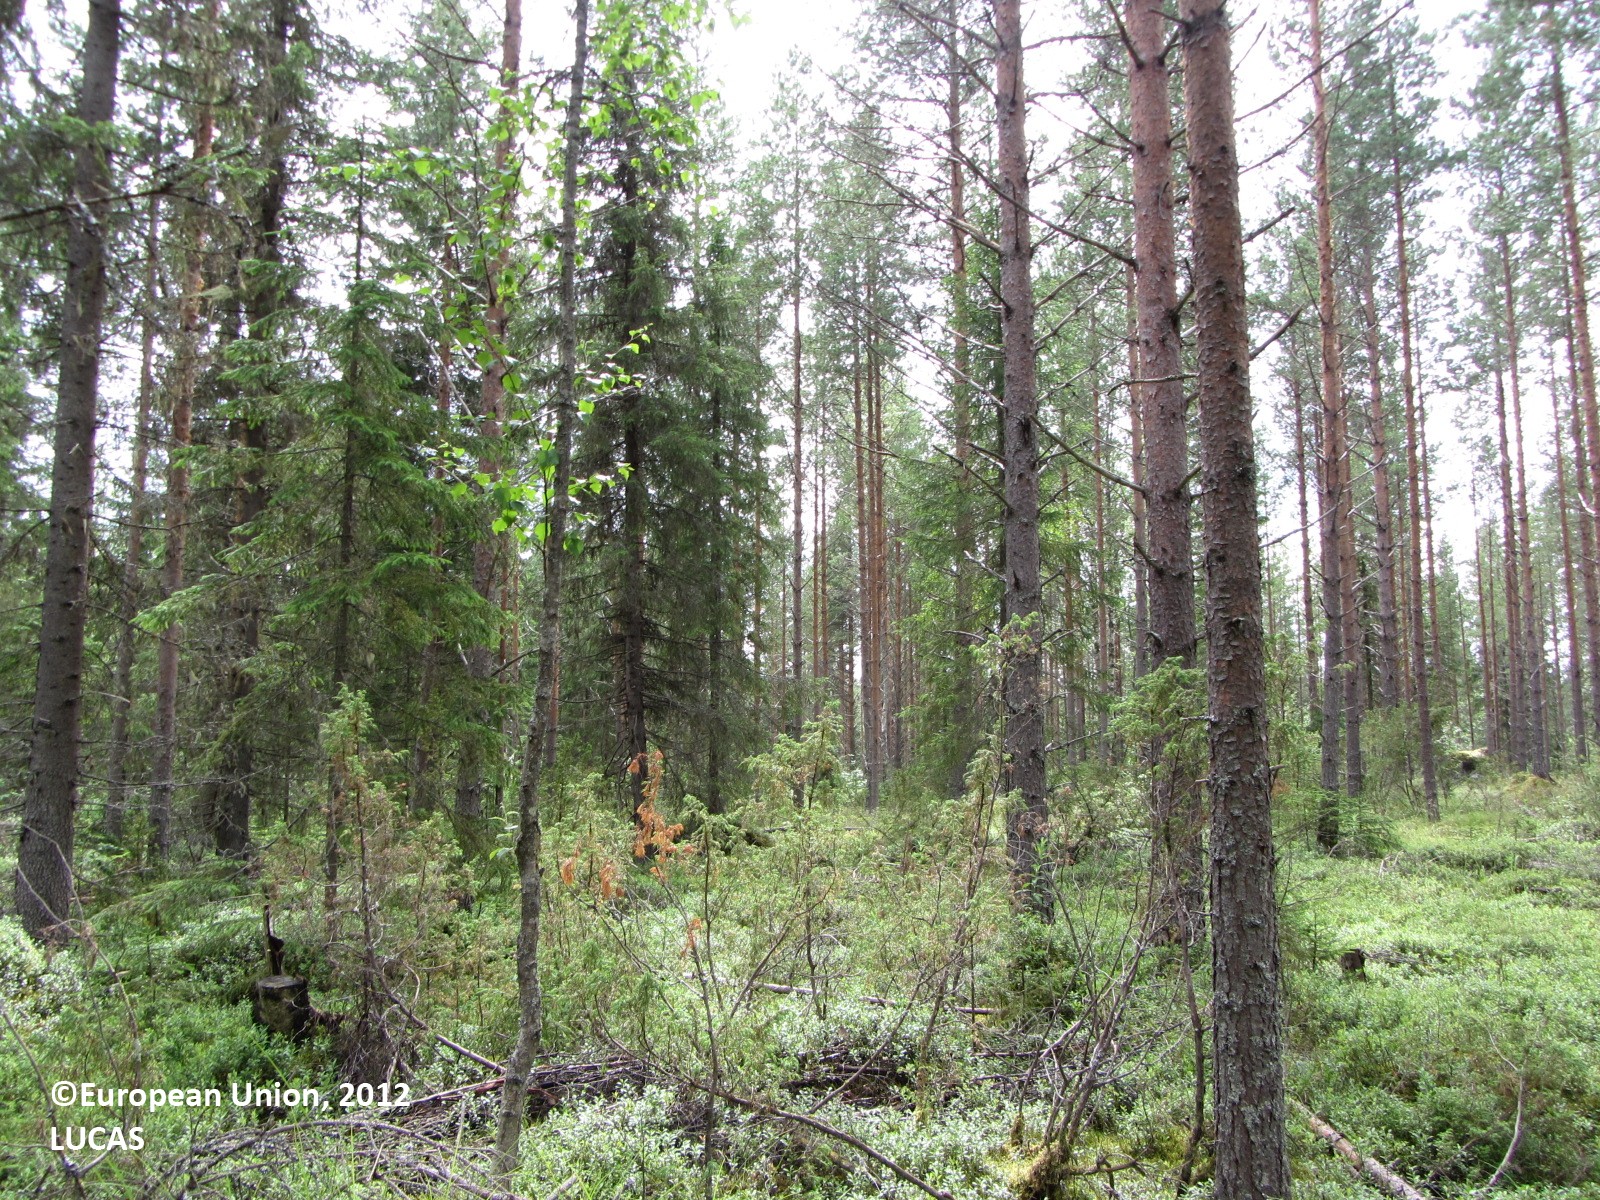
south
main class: Woodland
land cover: Other coniferous woodland
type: boreal forest
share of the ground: > 75 %
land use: Forestry
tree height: > 5 m
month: July
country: FI
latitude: 63.6945
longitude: 25.4078
